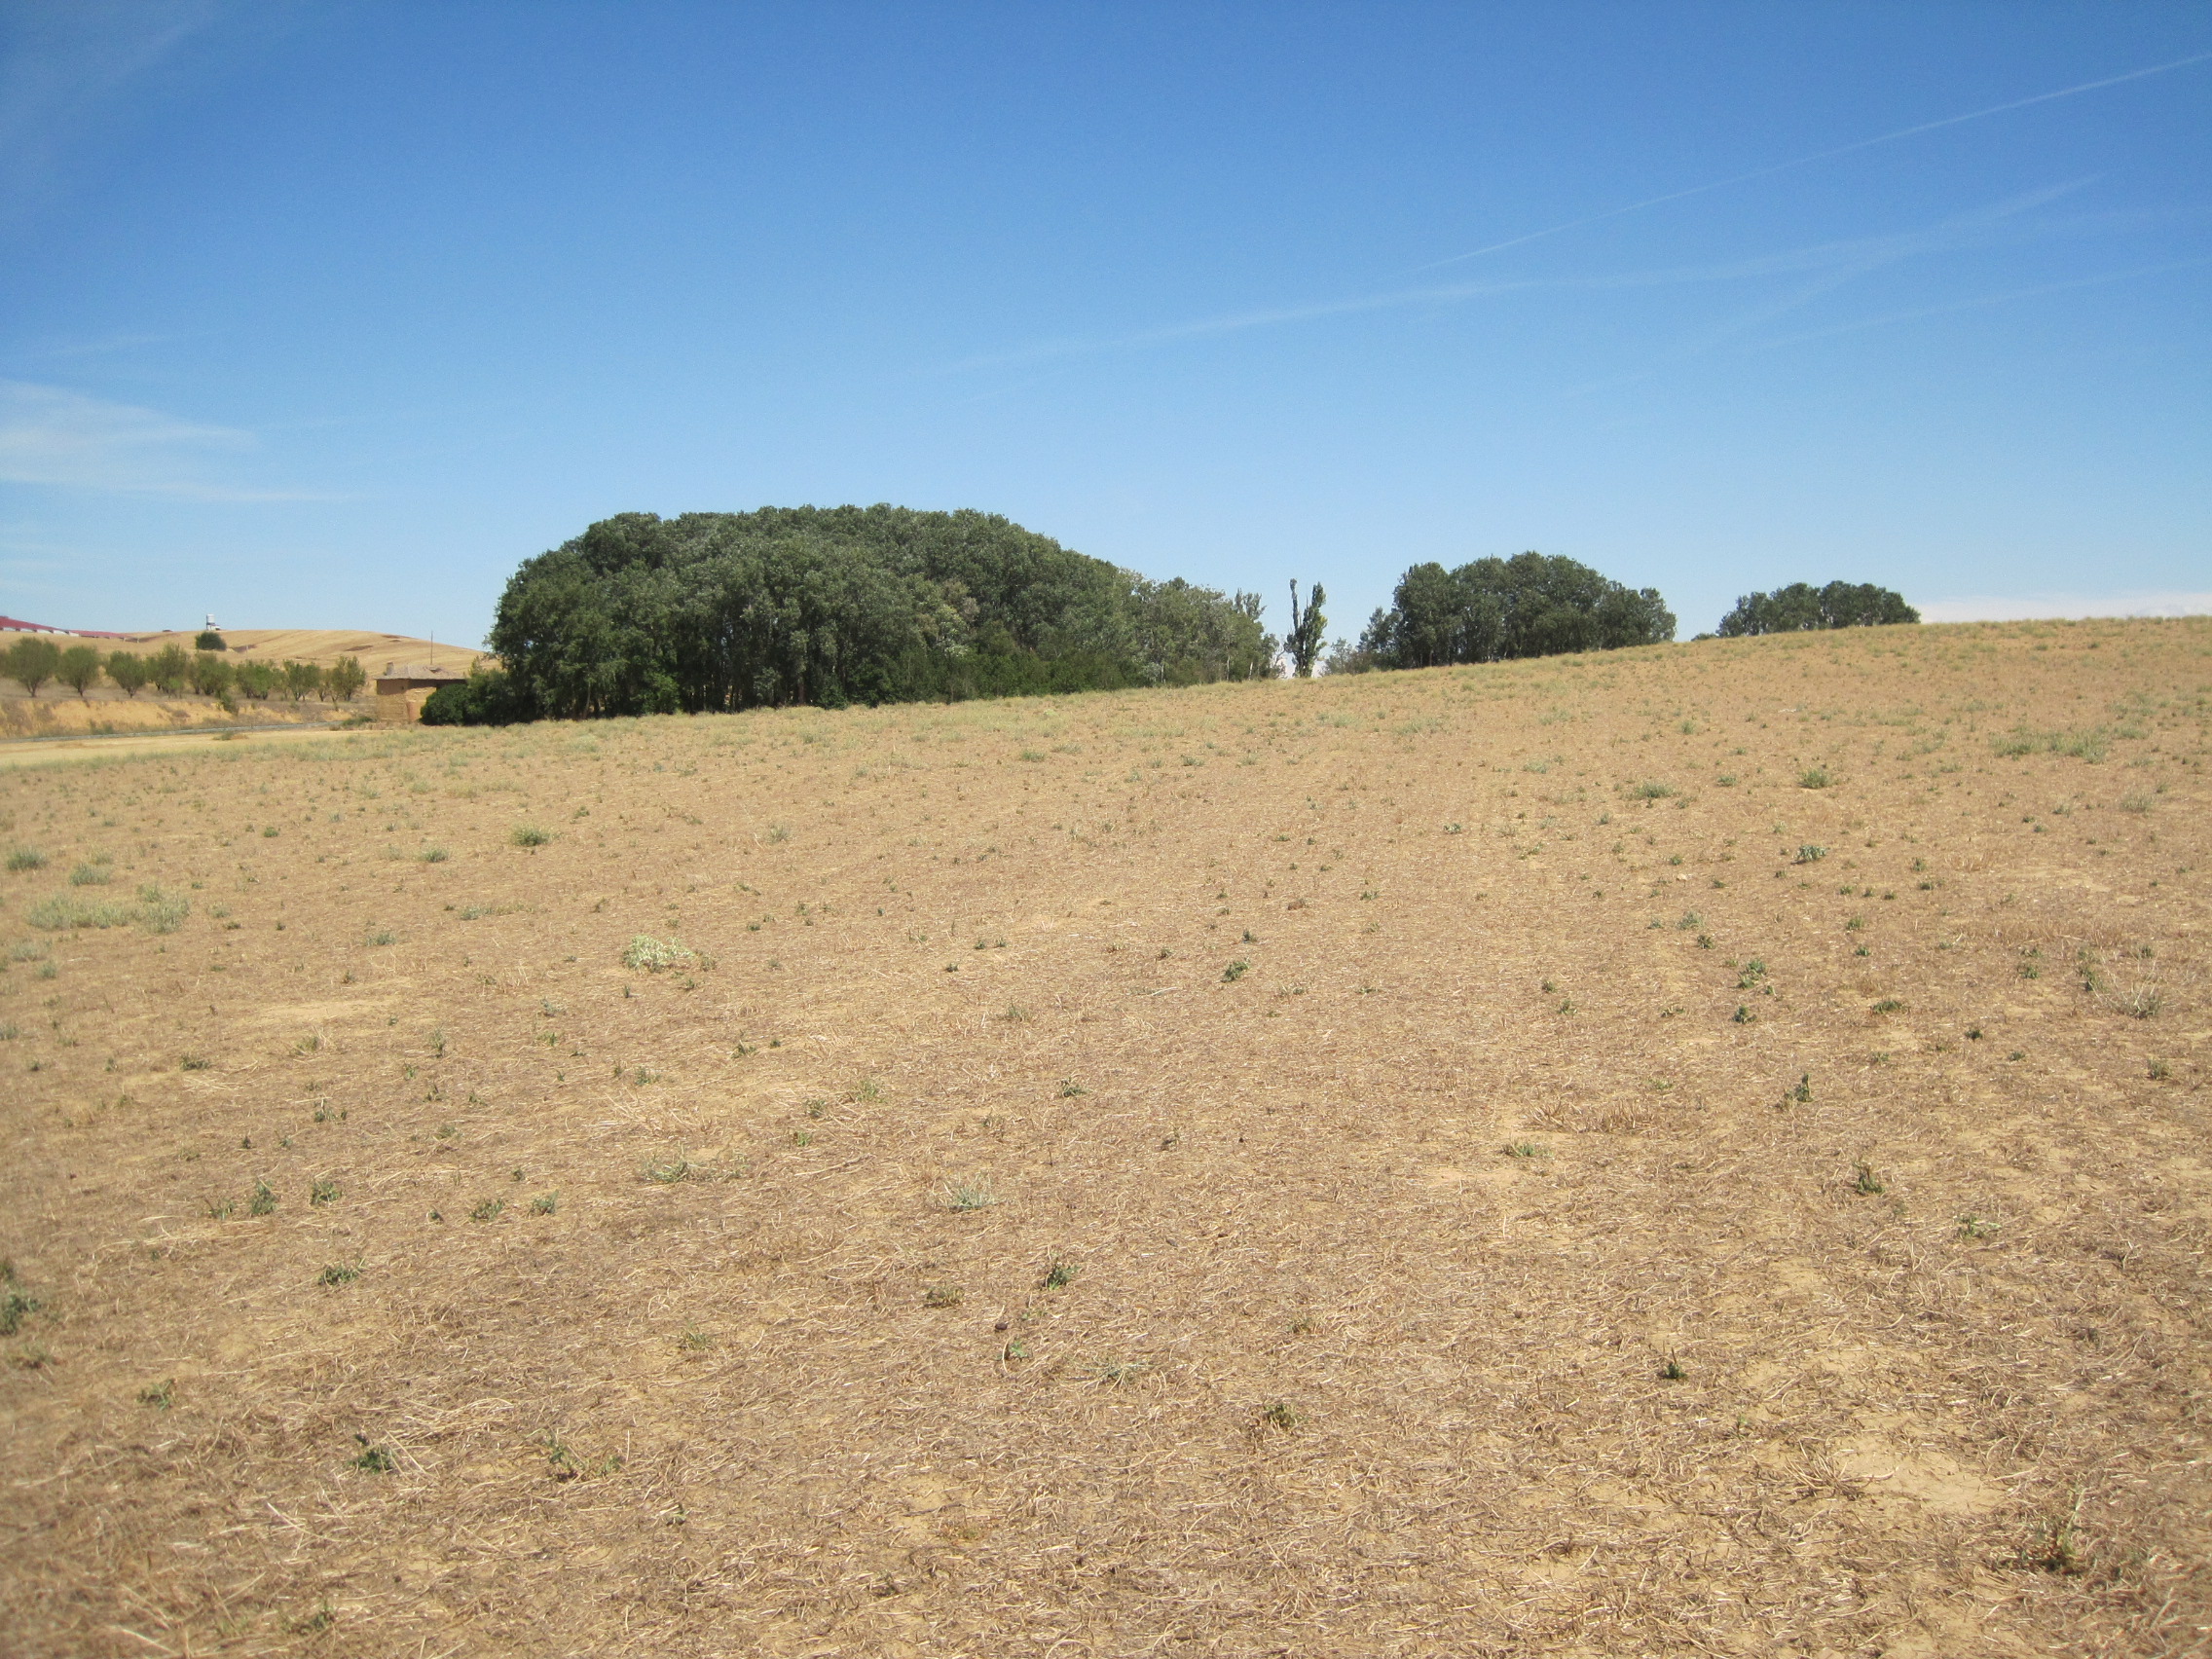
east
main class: Cropland
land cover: Dry pulses
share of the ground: < 10 %
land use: Agriculture (excluding fallow land and kitchen gardens)
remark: Harvested field
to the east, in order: Dry pulses; Grass margins; Barley; Grass margins; Broadleaved woodland
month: July
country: ES
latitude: 41.9792
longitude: -5.1797
